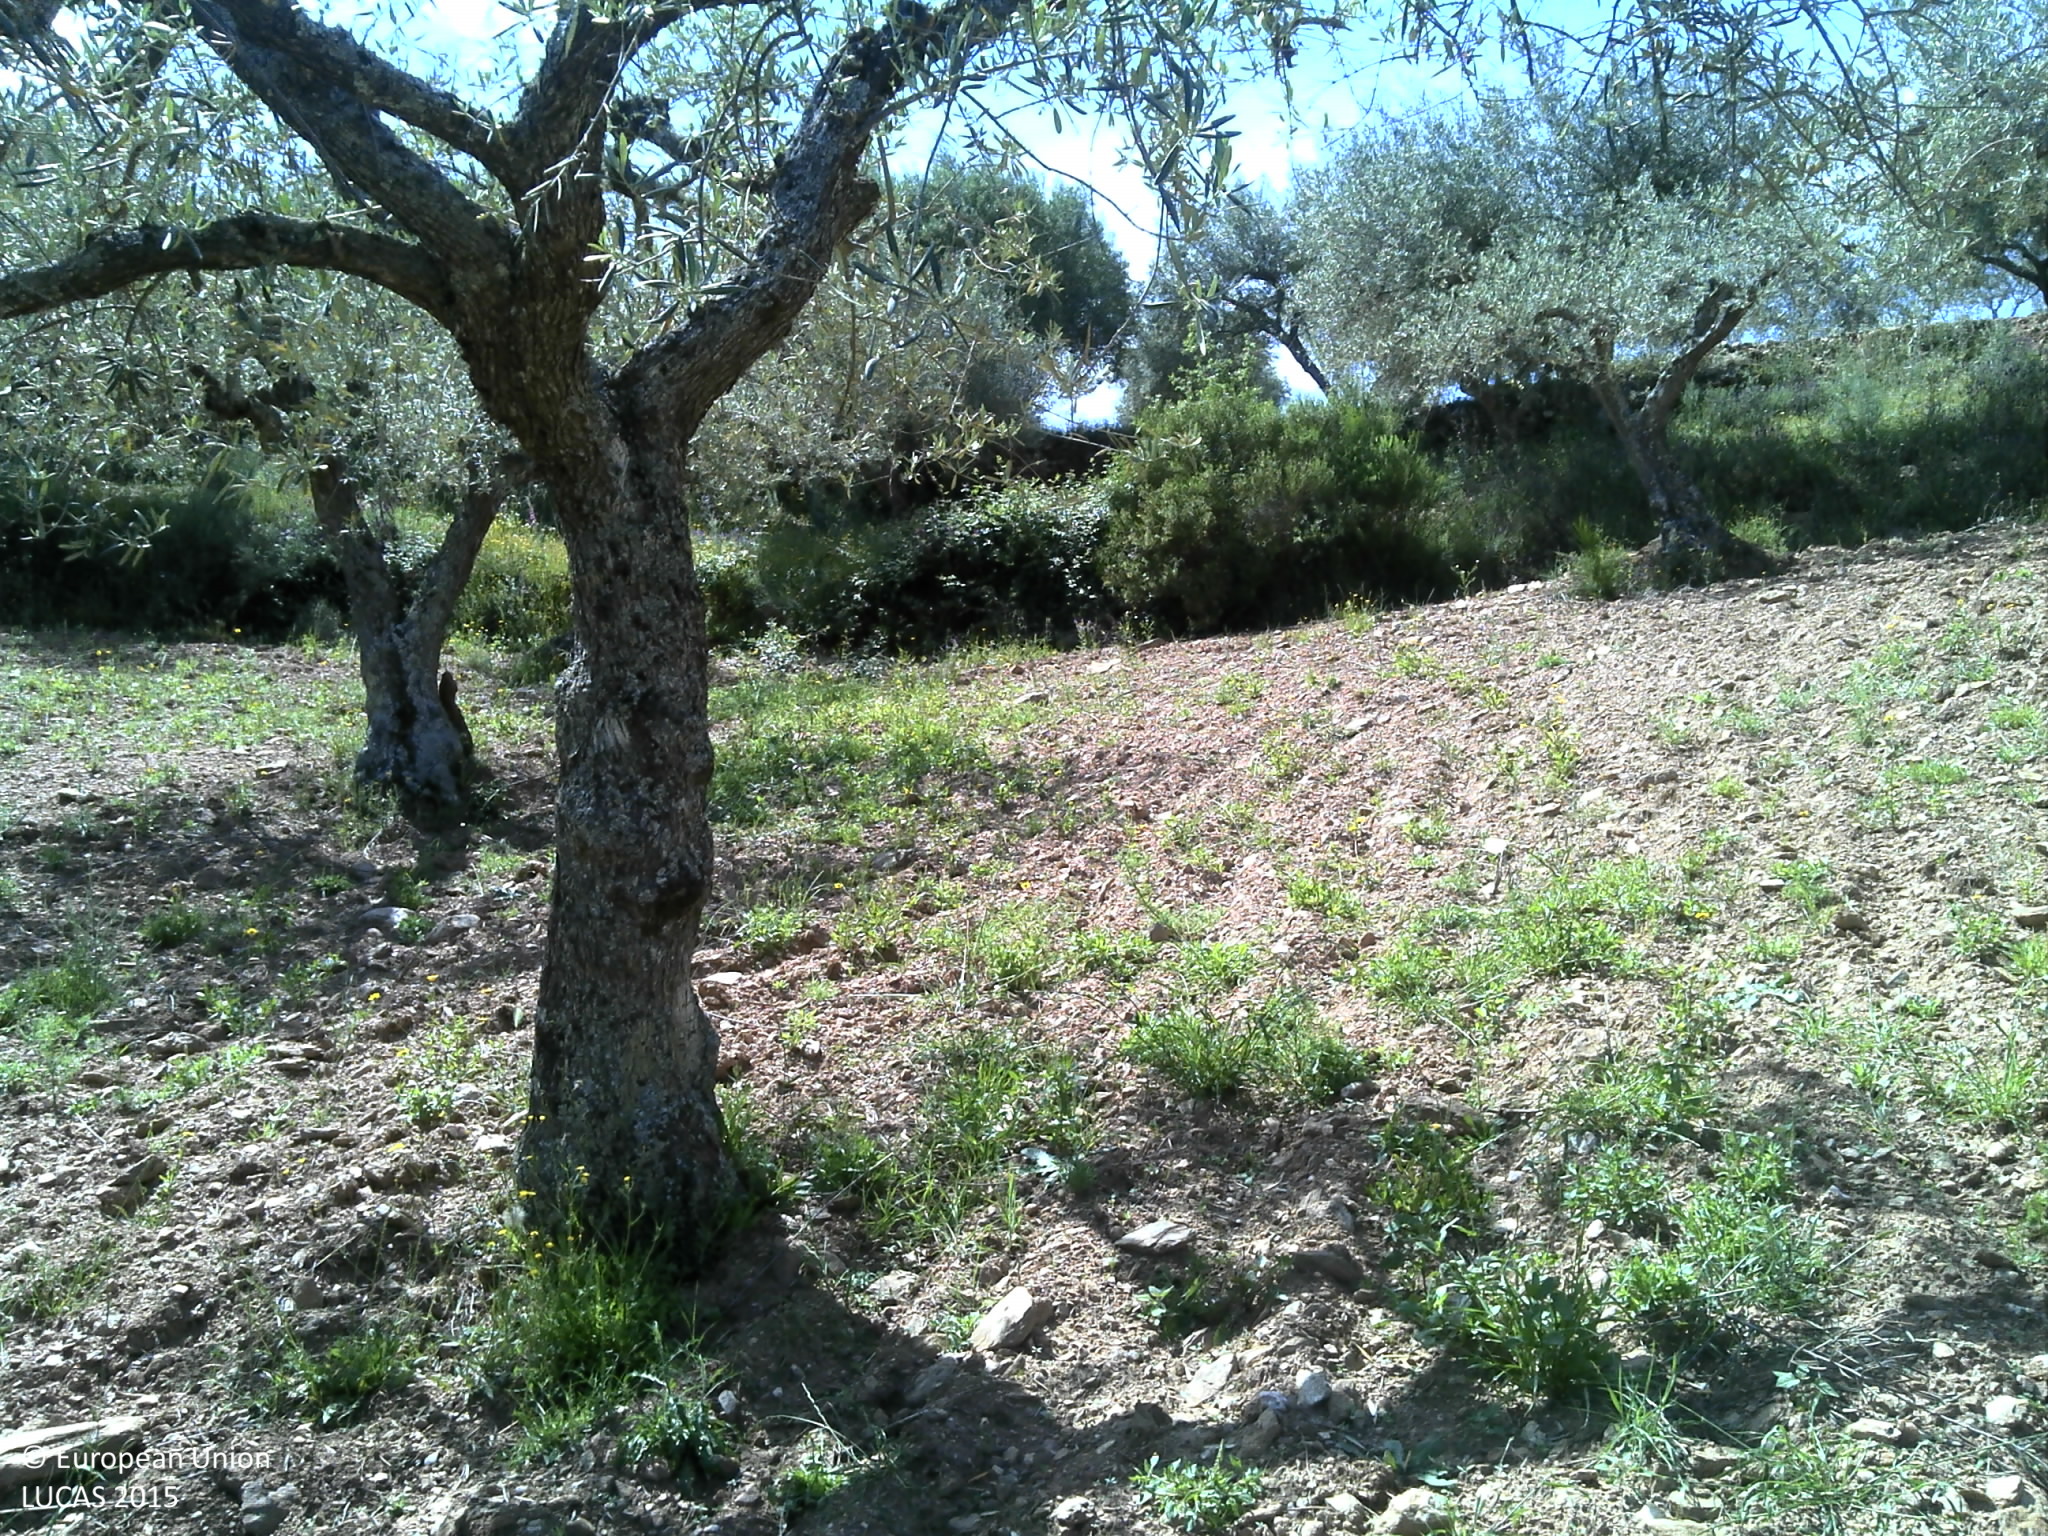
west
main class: Cropland
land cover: Olive groves
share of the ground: 25 - 50 %
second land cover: Spontaneously vegetated surfaces
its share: 10 - 25 %
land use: Agriculture (excluding fallow land and kitchen gardens)
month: May
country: PT
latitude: 41.5800
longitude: -7.0652
